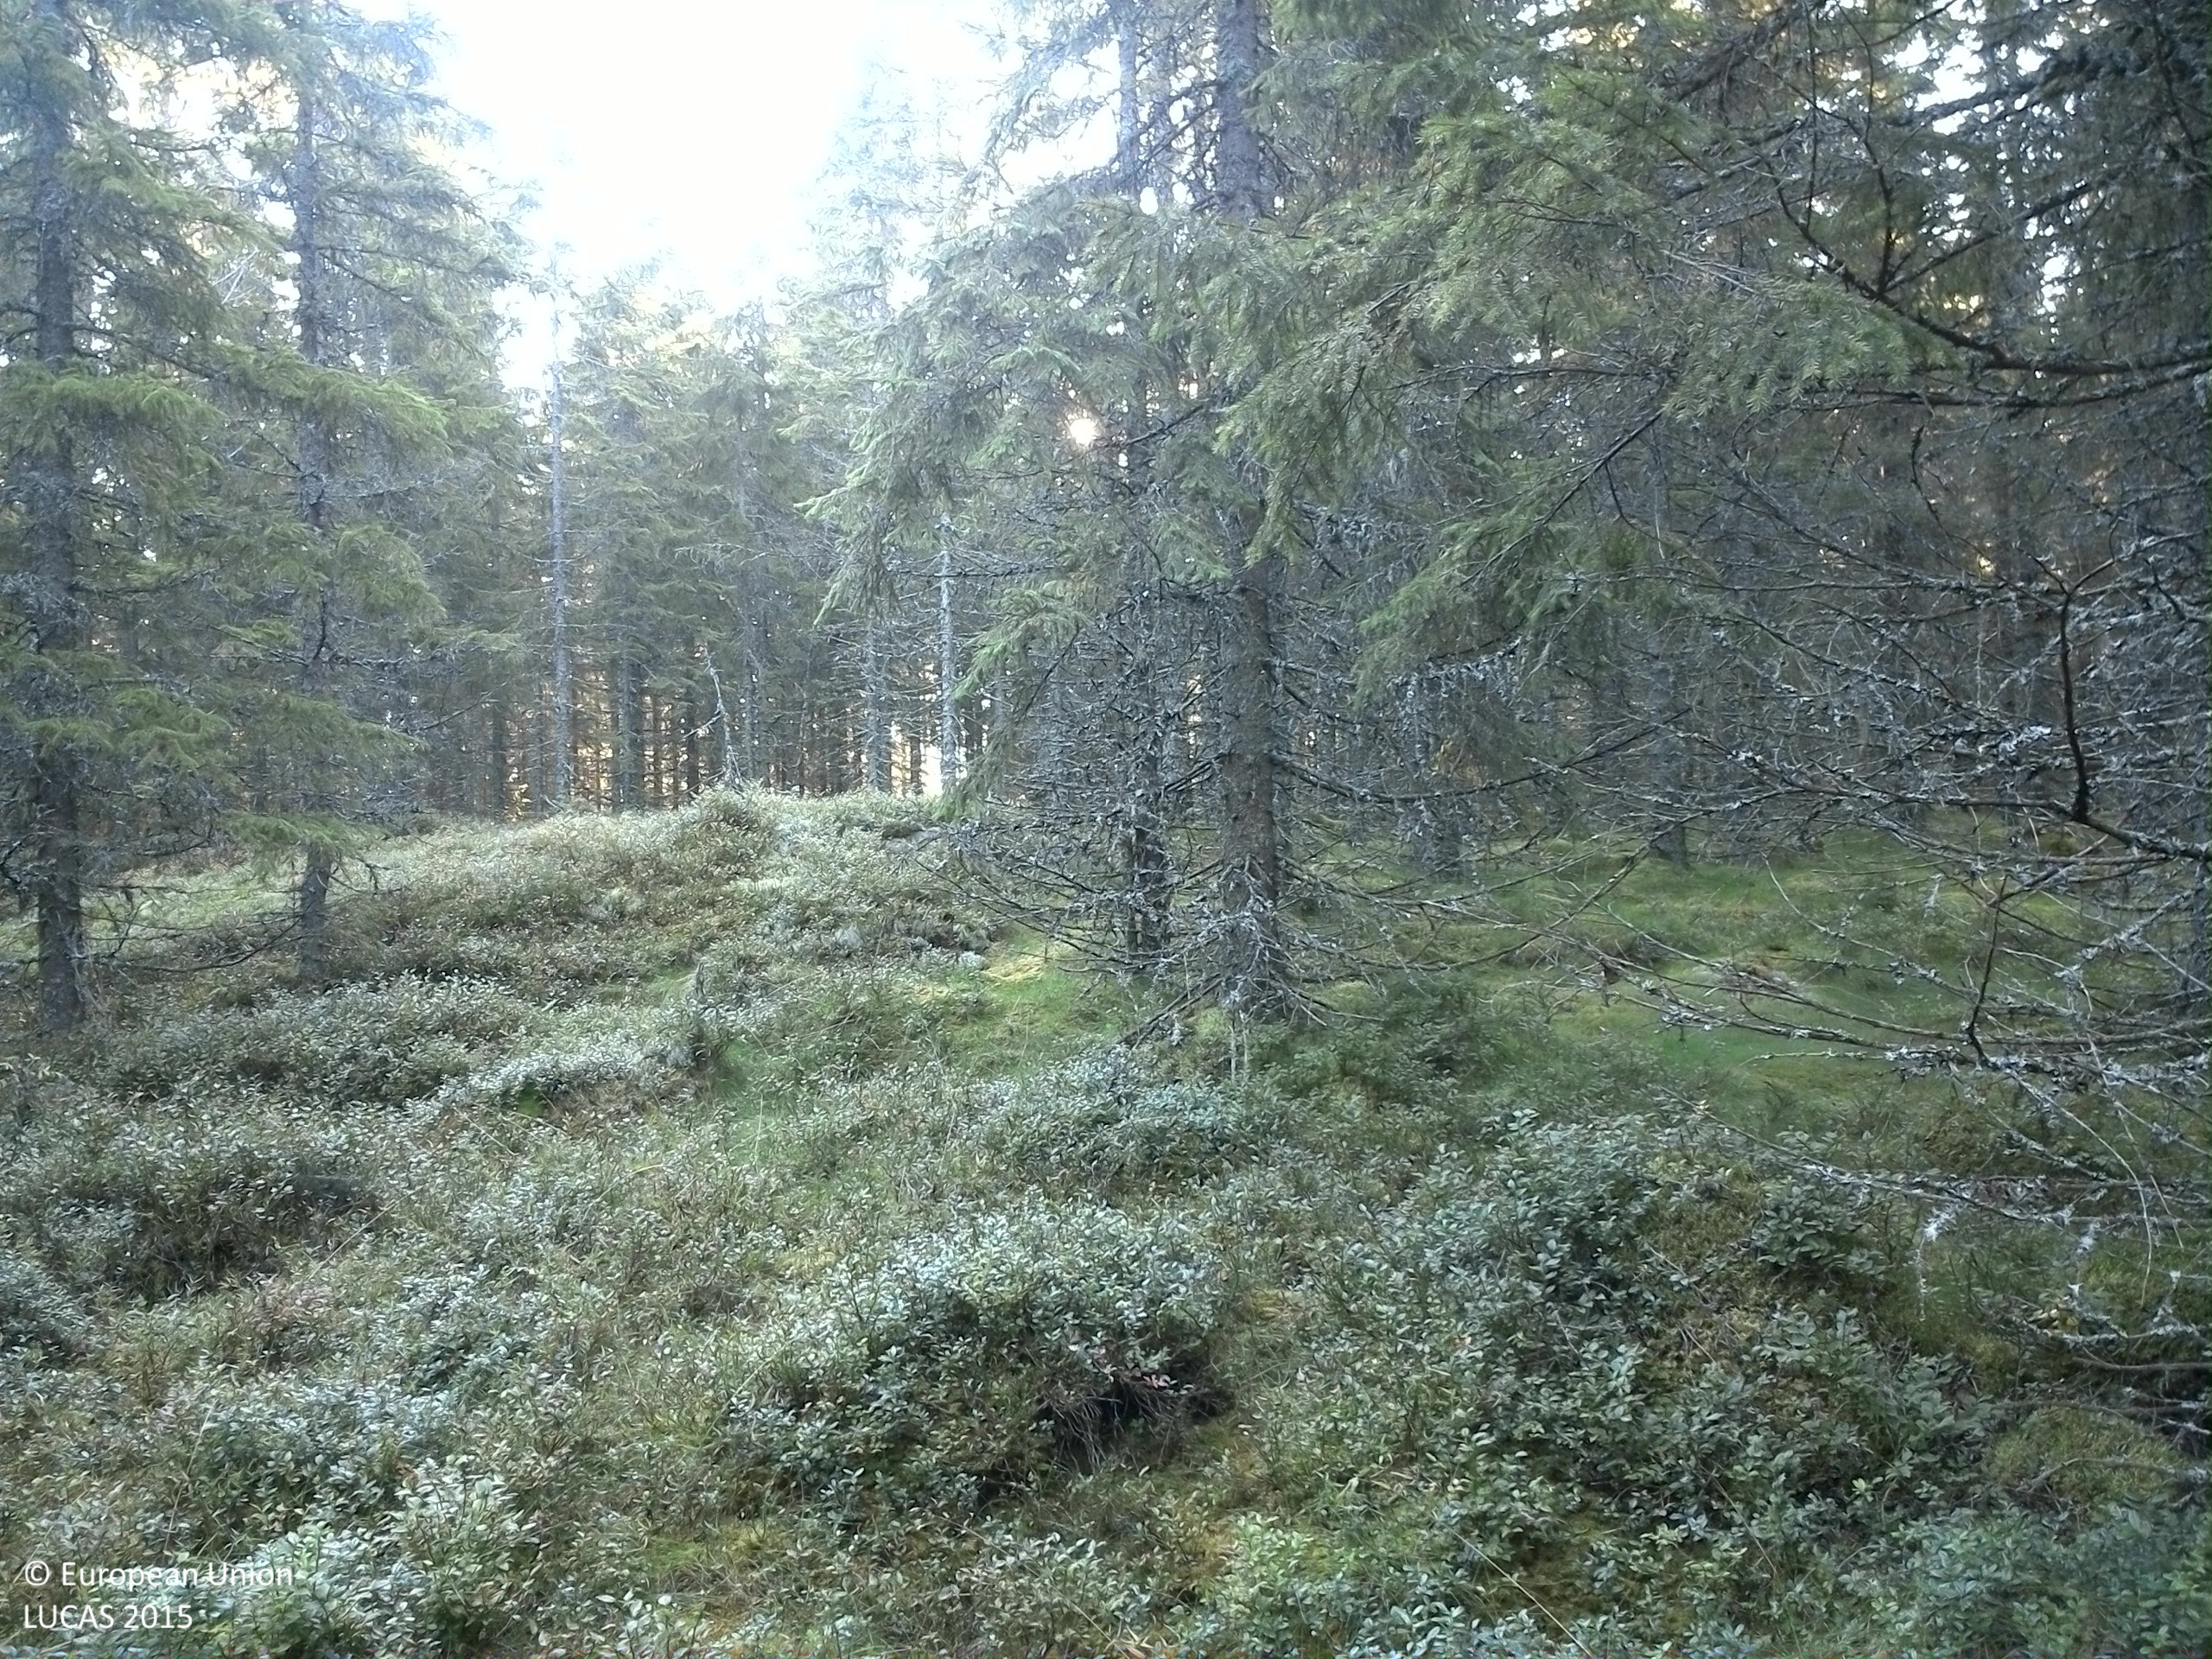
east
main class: Woodland
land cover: Spruce dominated coniferous woodland
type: boreal forest
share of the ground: 50 - 75 %
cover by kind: coniferous forest trees 70 %, shrubs 20 %, lichens and mosses 10 %
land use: Forestry
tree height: > 5 m
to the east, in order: Spruce dominated coniferous woodland; Tracks; Spruce dominated coniferous woodland; Pine dominated coniferous woodland; Spruce dominated coniferous woodland; Pine dominated coniferous woodland
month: September
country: SE
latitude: 59.8694
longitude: 13.4025
